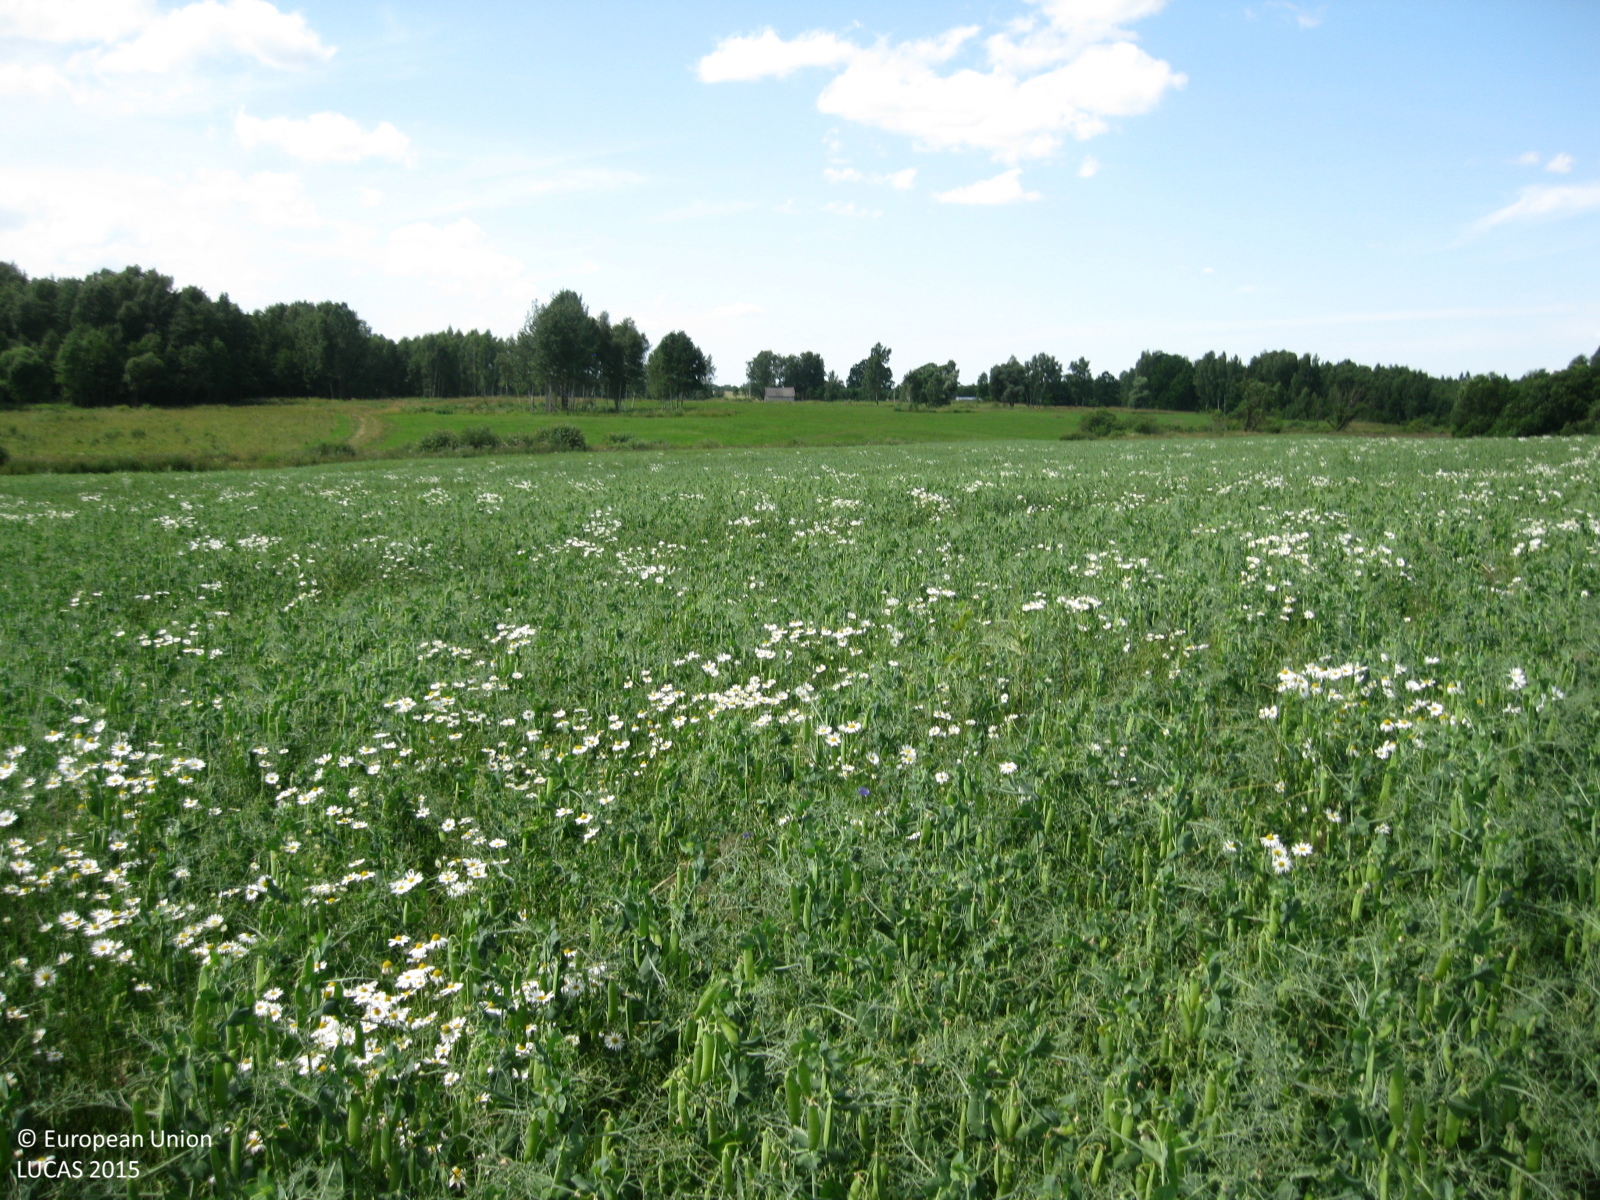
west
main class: Cropland
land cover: Dry pulses
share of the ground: > 75 %
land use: Agriculture (excluding fallow land and kitchen gardens)
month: July
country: LT
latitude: 55.0867
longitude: 24.6275
